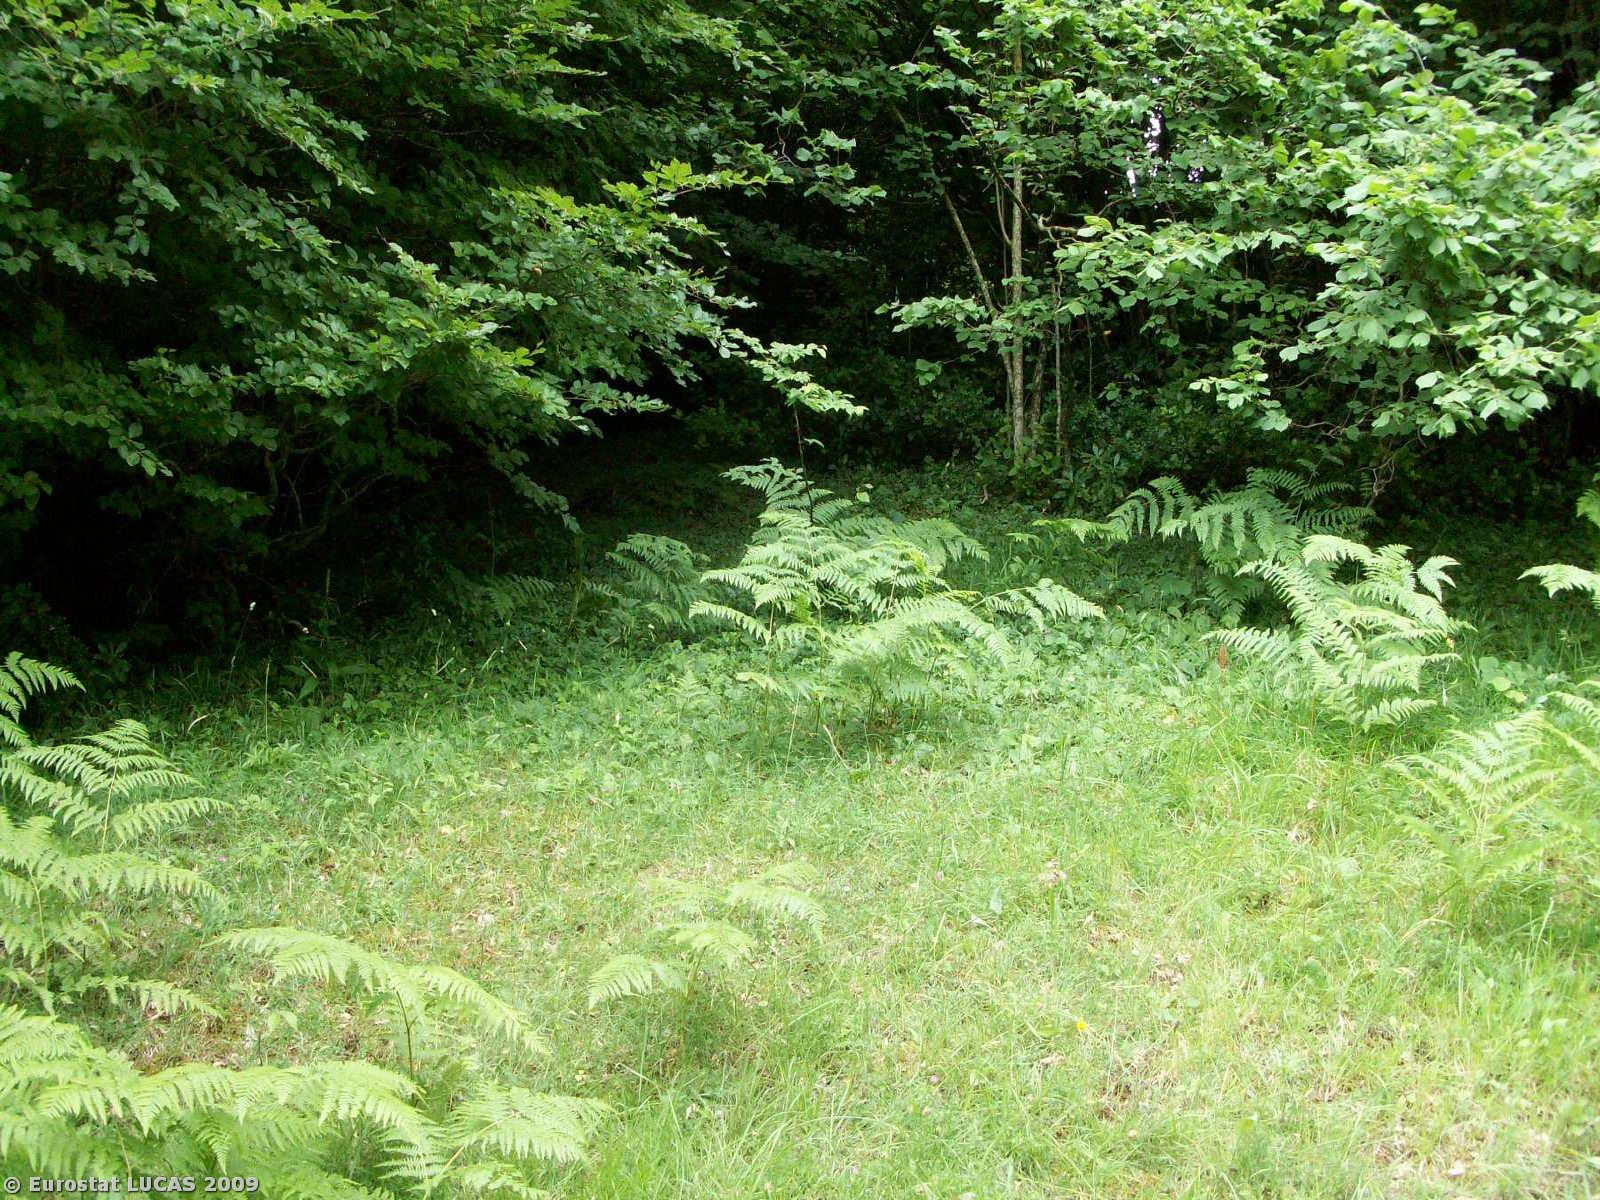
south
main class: Woodland
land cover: Broadleaved woodland
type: mesophytic deciduous forest
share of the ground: > 75 %
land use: Agriculture (excluding fallow land and kitchen gardens)
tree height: > 5 m
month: June
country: IT
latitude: 39.8633
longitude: 16.0402
